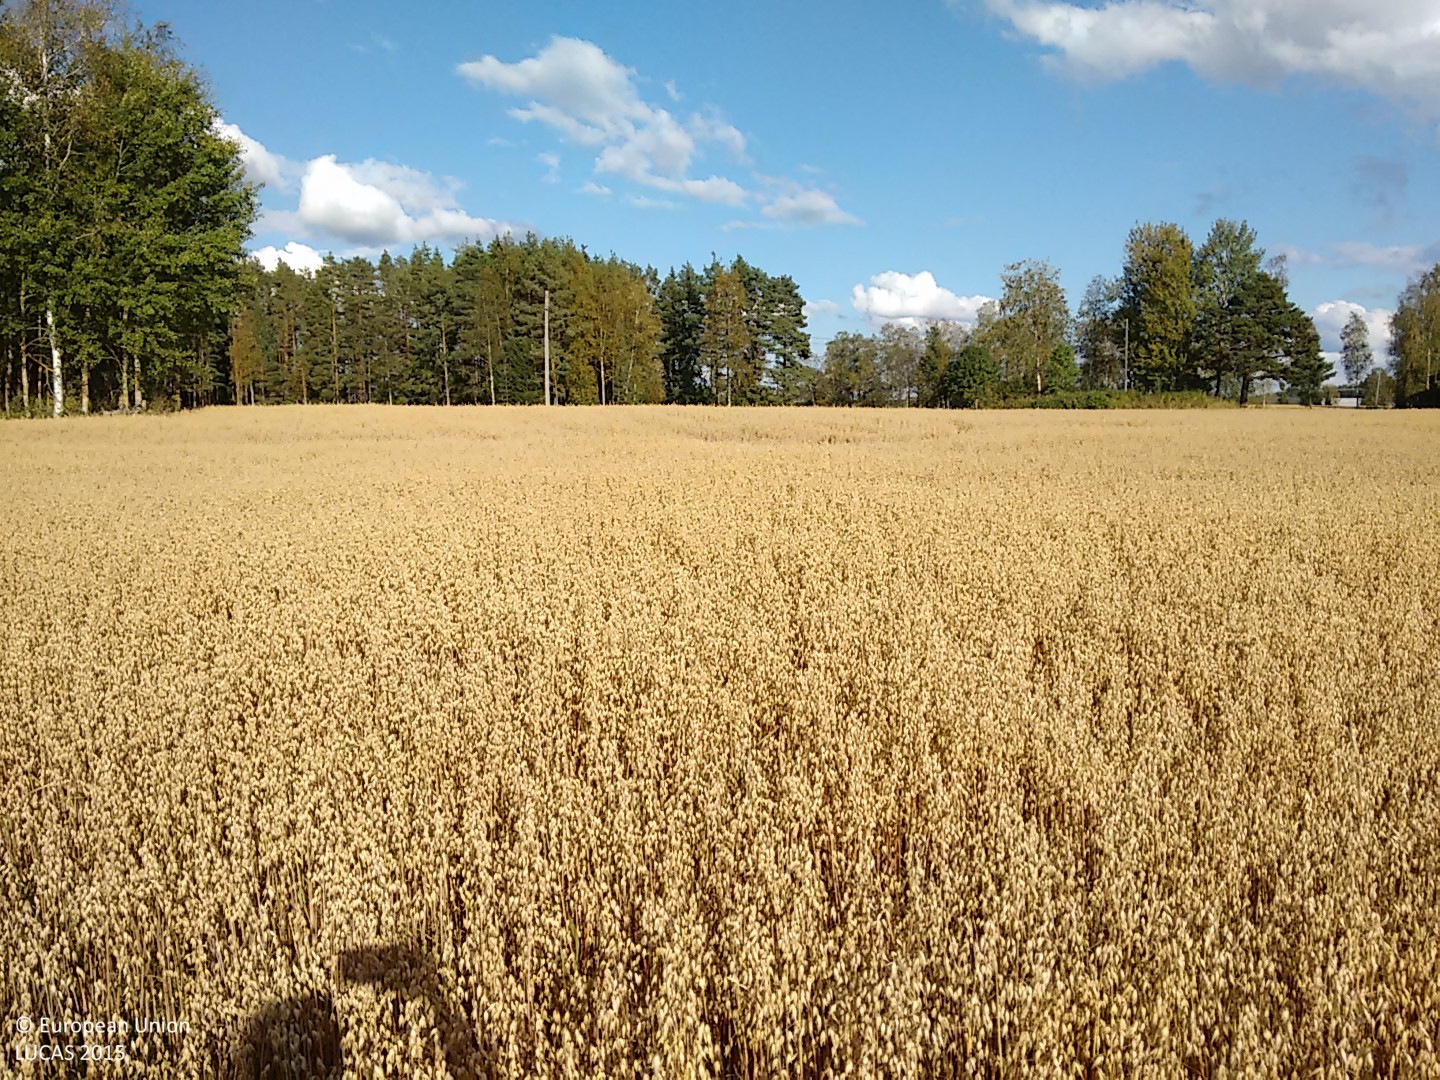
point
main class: Cropland
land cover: Oats
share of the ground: > 75 %
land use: Agriculture (excluding fallow land and kitchen gardens)
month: September
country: FI
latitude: 60.9643
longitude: 21.7485
